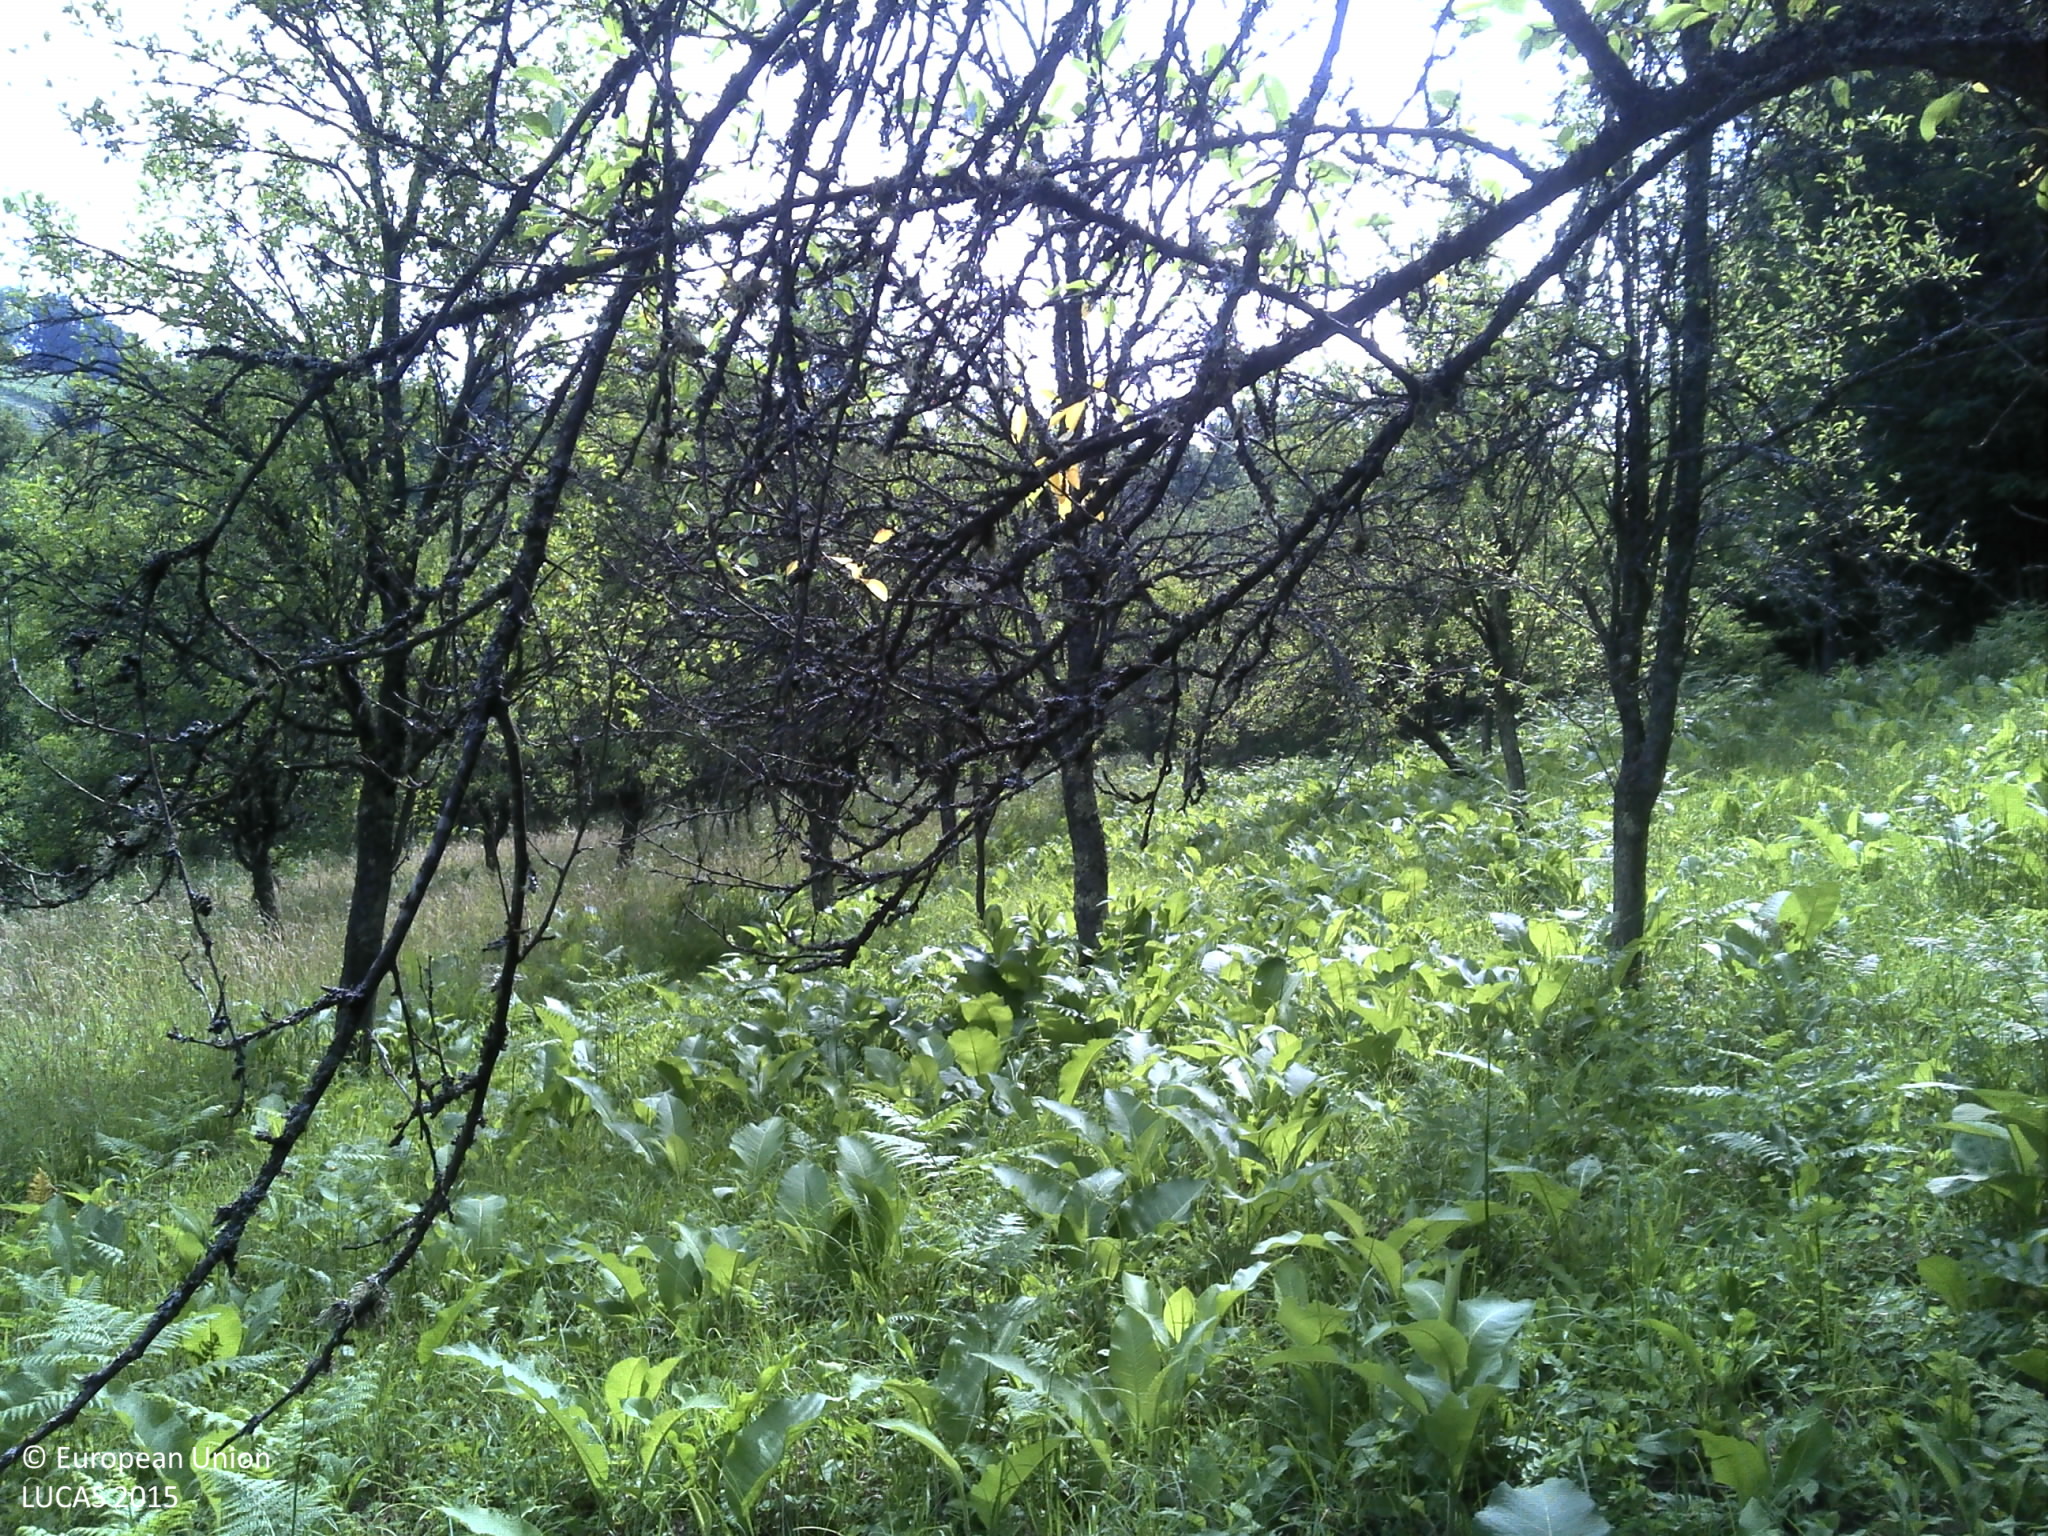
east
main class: Cropland
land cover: Other fruit trees and berries
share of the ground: > 75 %
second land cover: Grassland without tree/shrub cover
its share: > 75 %
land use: Agriculture (excluding fallow land and kitchen gardens)
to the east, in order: Other fruit trees and berries; Grassland without tree/shrub cover; Shrubland with sparse tree cover; Grassland without tree/shrub cover; Vineyards; Tracks; Grassland without tree/shrub cover
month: June
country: HR
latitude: 45.3195
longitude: 17.6172
